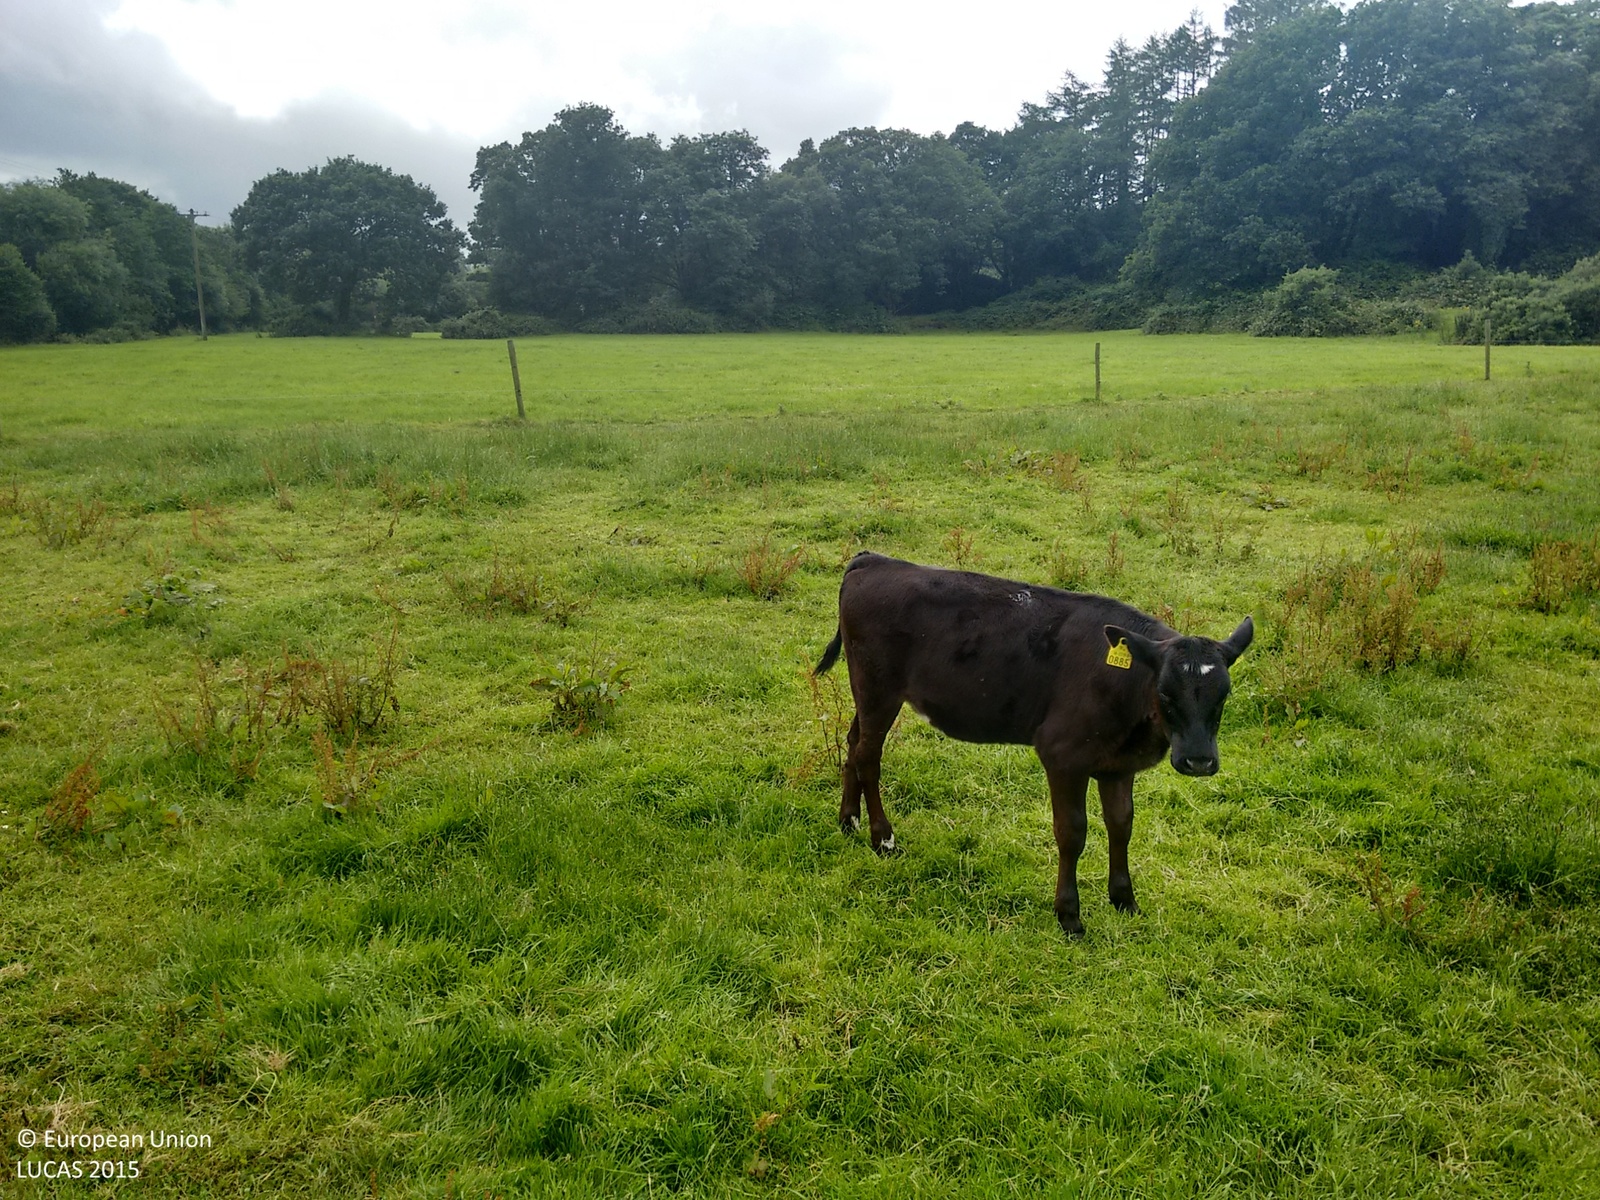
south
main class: Grassland
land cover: Grassland without tree/shrub cover
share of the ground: > 75 %
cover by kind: herbaceous plants 95 %, shrubs 5 %
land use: Agriculture (excluding fallow land and kitchen gardens)
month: July
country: IE
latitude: 51.9274
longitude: -9.1378
